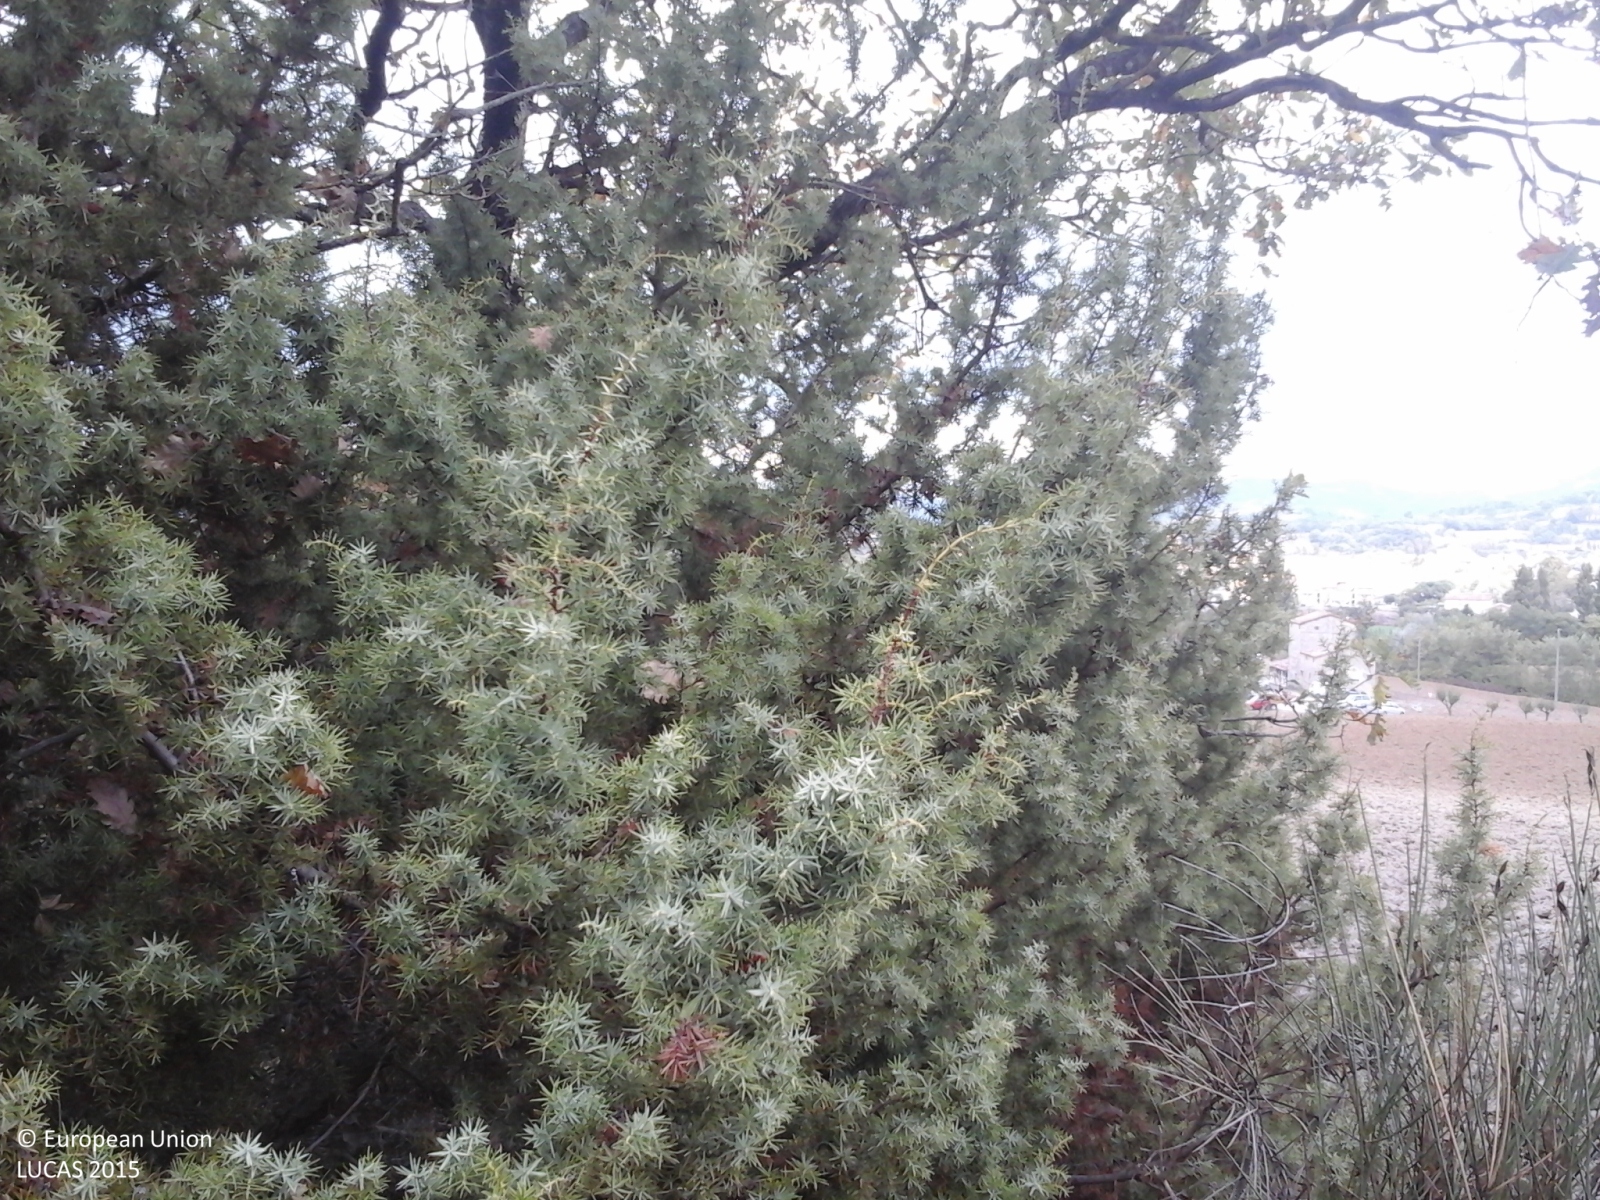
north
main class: Woodland
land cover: Pine dominated mixed woodland
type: coniferous forest of the mediterranean region
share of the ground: > 75 %
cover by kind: coniferous forest trees 50 %, broadleaved forest trees 35 %, shrubs 15 %
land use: Forestry
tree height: > 5 m
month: October
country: IT
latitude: 43.2957
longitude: 12.3231
